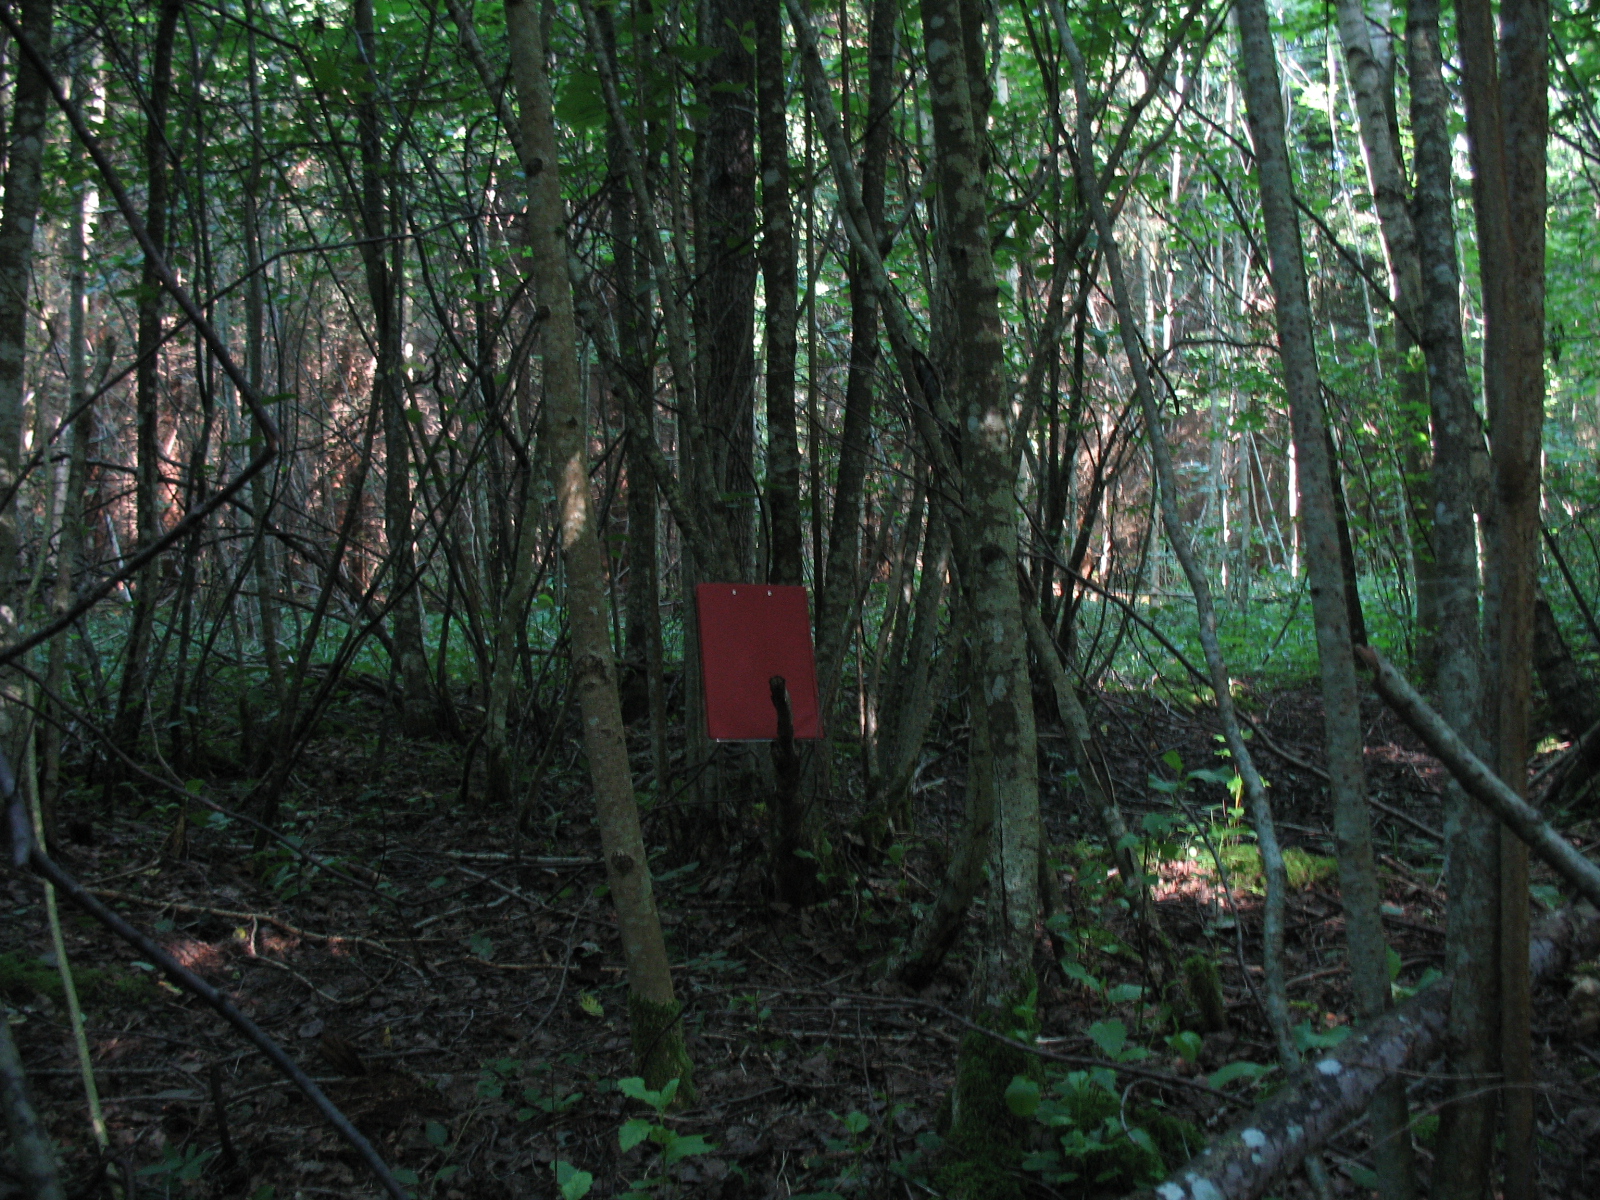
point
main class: Woodland
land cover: Broadleaved woodland
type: non-riverine alder, birch or aspen forest
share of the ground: > 75 %
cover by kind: broadleaved forest trees 90 %, shrubs 5 %, herbaceous plants 5 %
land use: Forestry
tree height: > 5 m
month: July
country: LV
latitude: 56.2224
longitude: 25.0937
